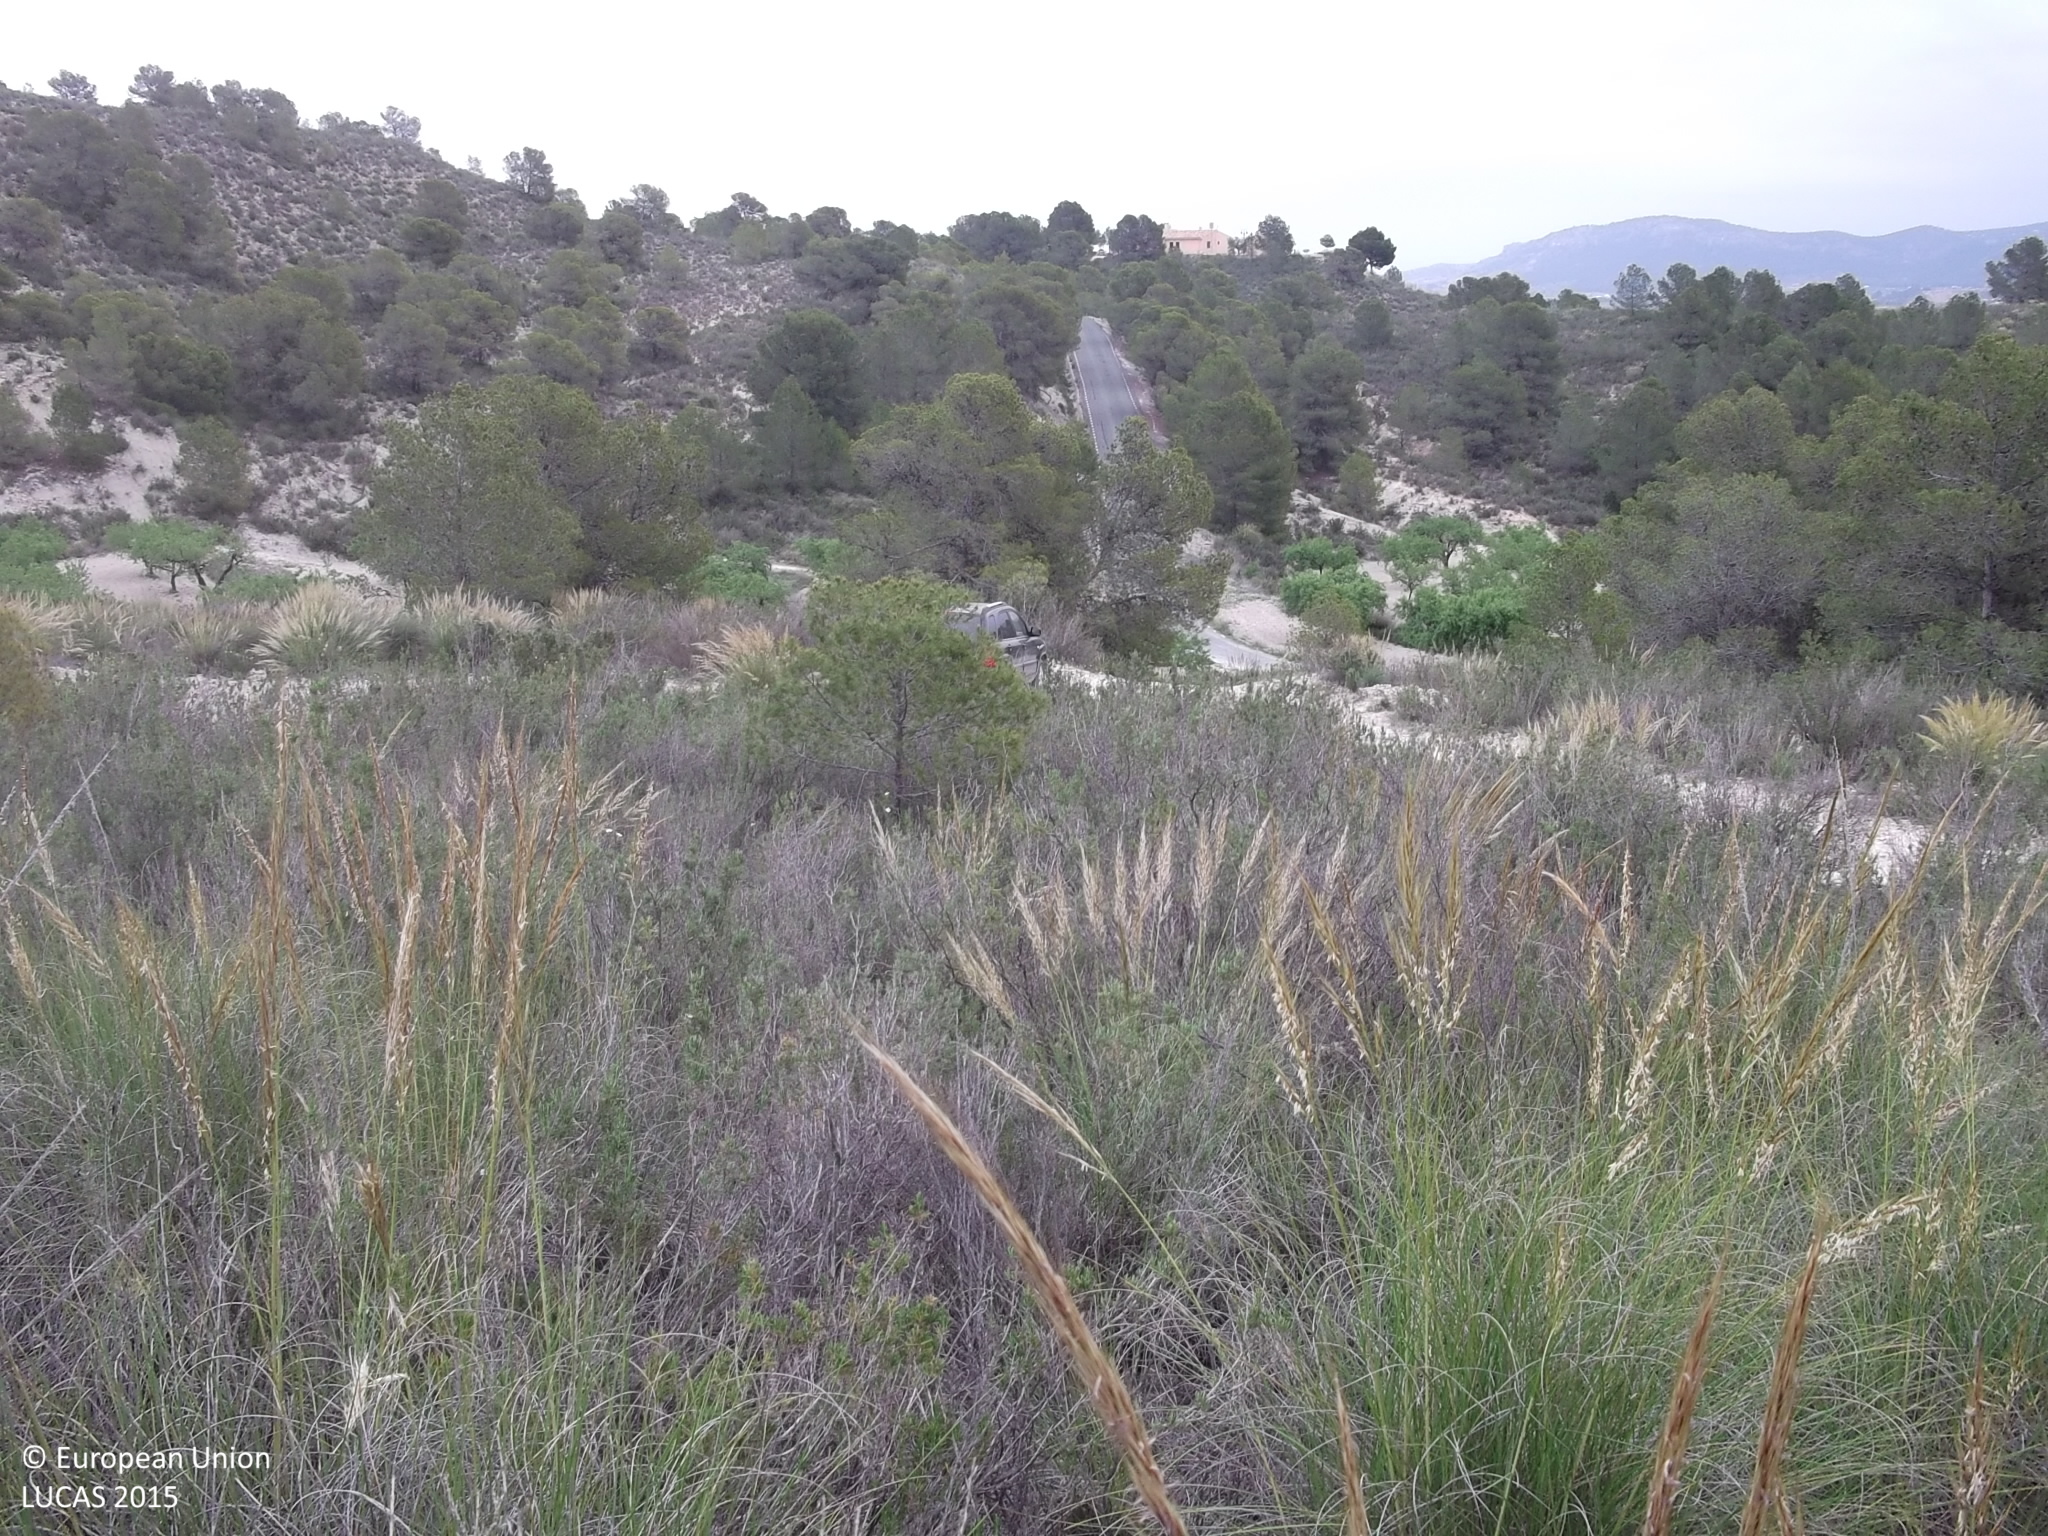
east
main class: Shrubland
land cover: Shrubland without tree cover
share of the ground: 25 - 50 %
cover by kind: herbaceous plants 60 %, shrubs 40 %
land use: Semi-natural and natural areas not in use
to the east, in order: Shrubland without tree cover; Tracks; Pine dominated coniferous woodland; Grass margins; Nuts trees; Pine dominated coniferous woodland
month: April
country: ES
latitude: 38.0266
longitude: -1.5723
